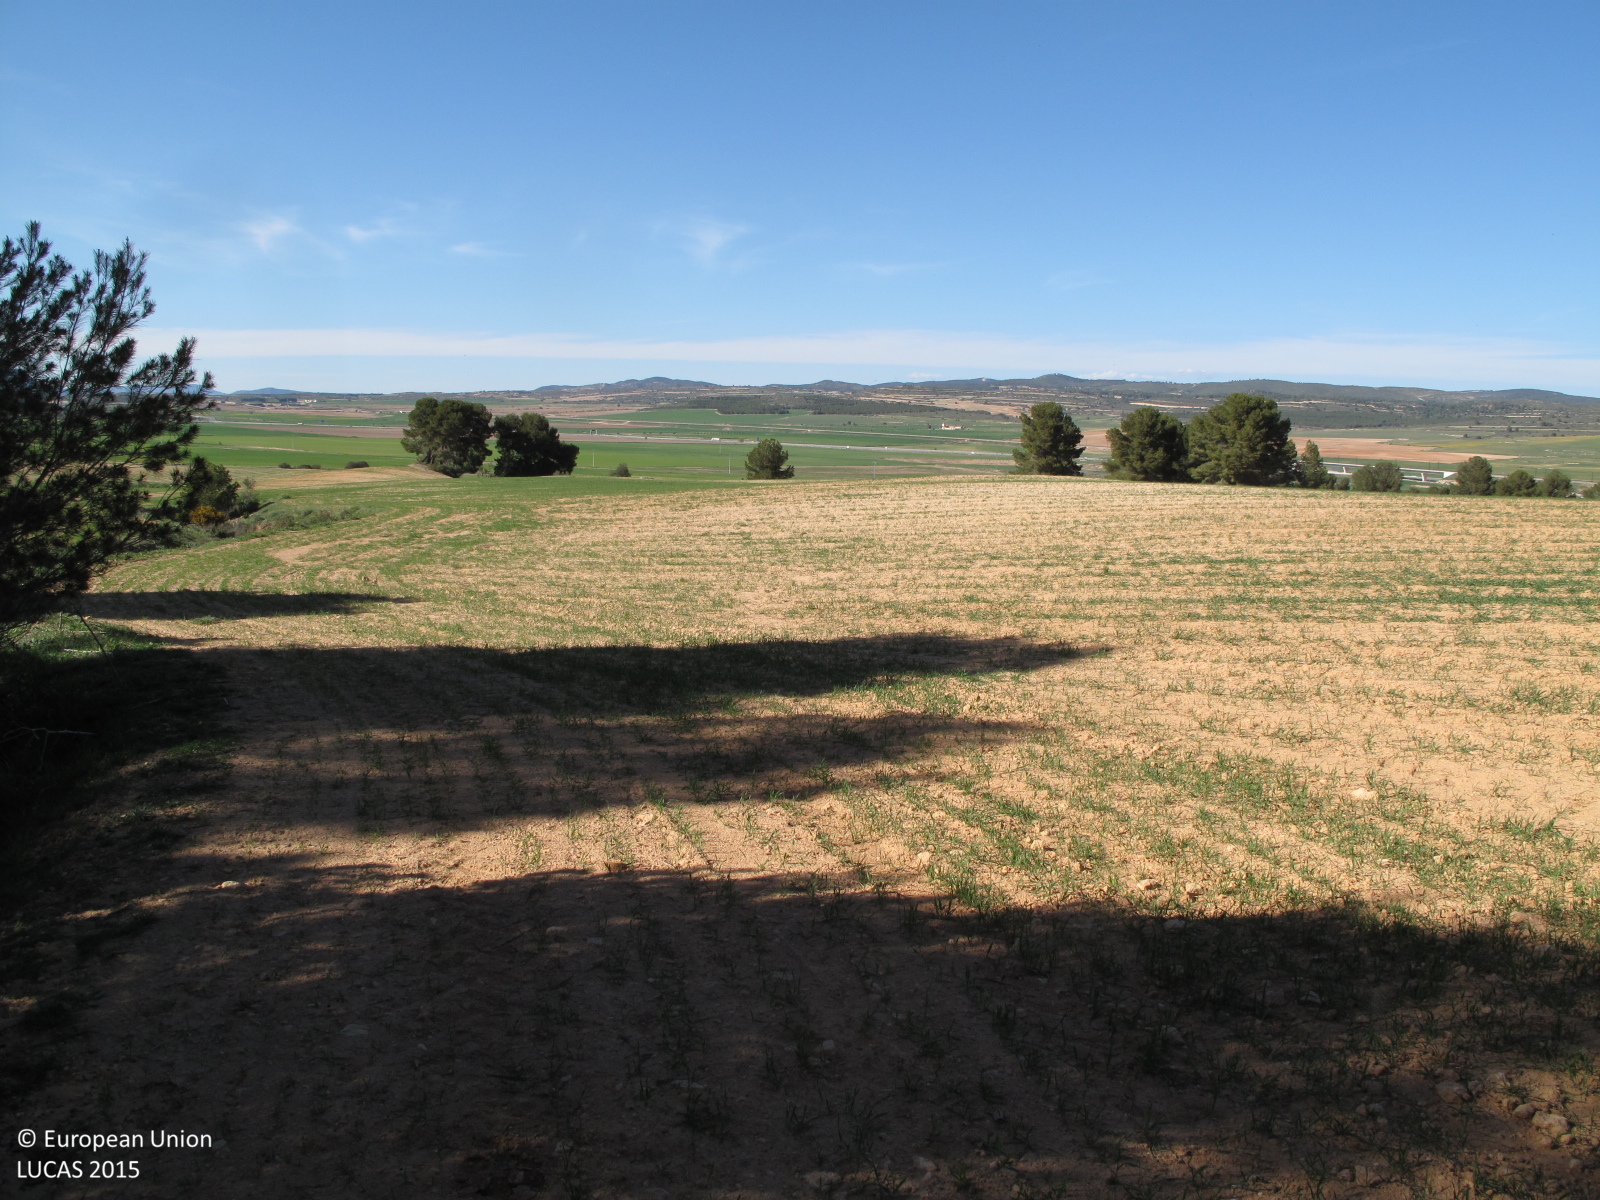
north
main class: Cropland
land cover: Barley
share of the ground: 10 - 25 %
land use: Agriculture (excluding fallow land and kitchen gardens)
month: March
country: ES
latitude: 38.8262
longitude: -0.9933
